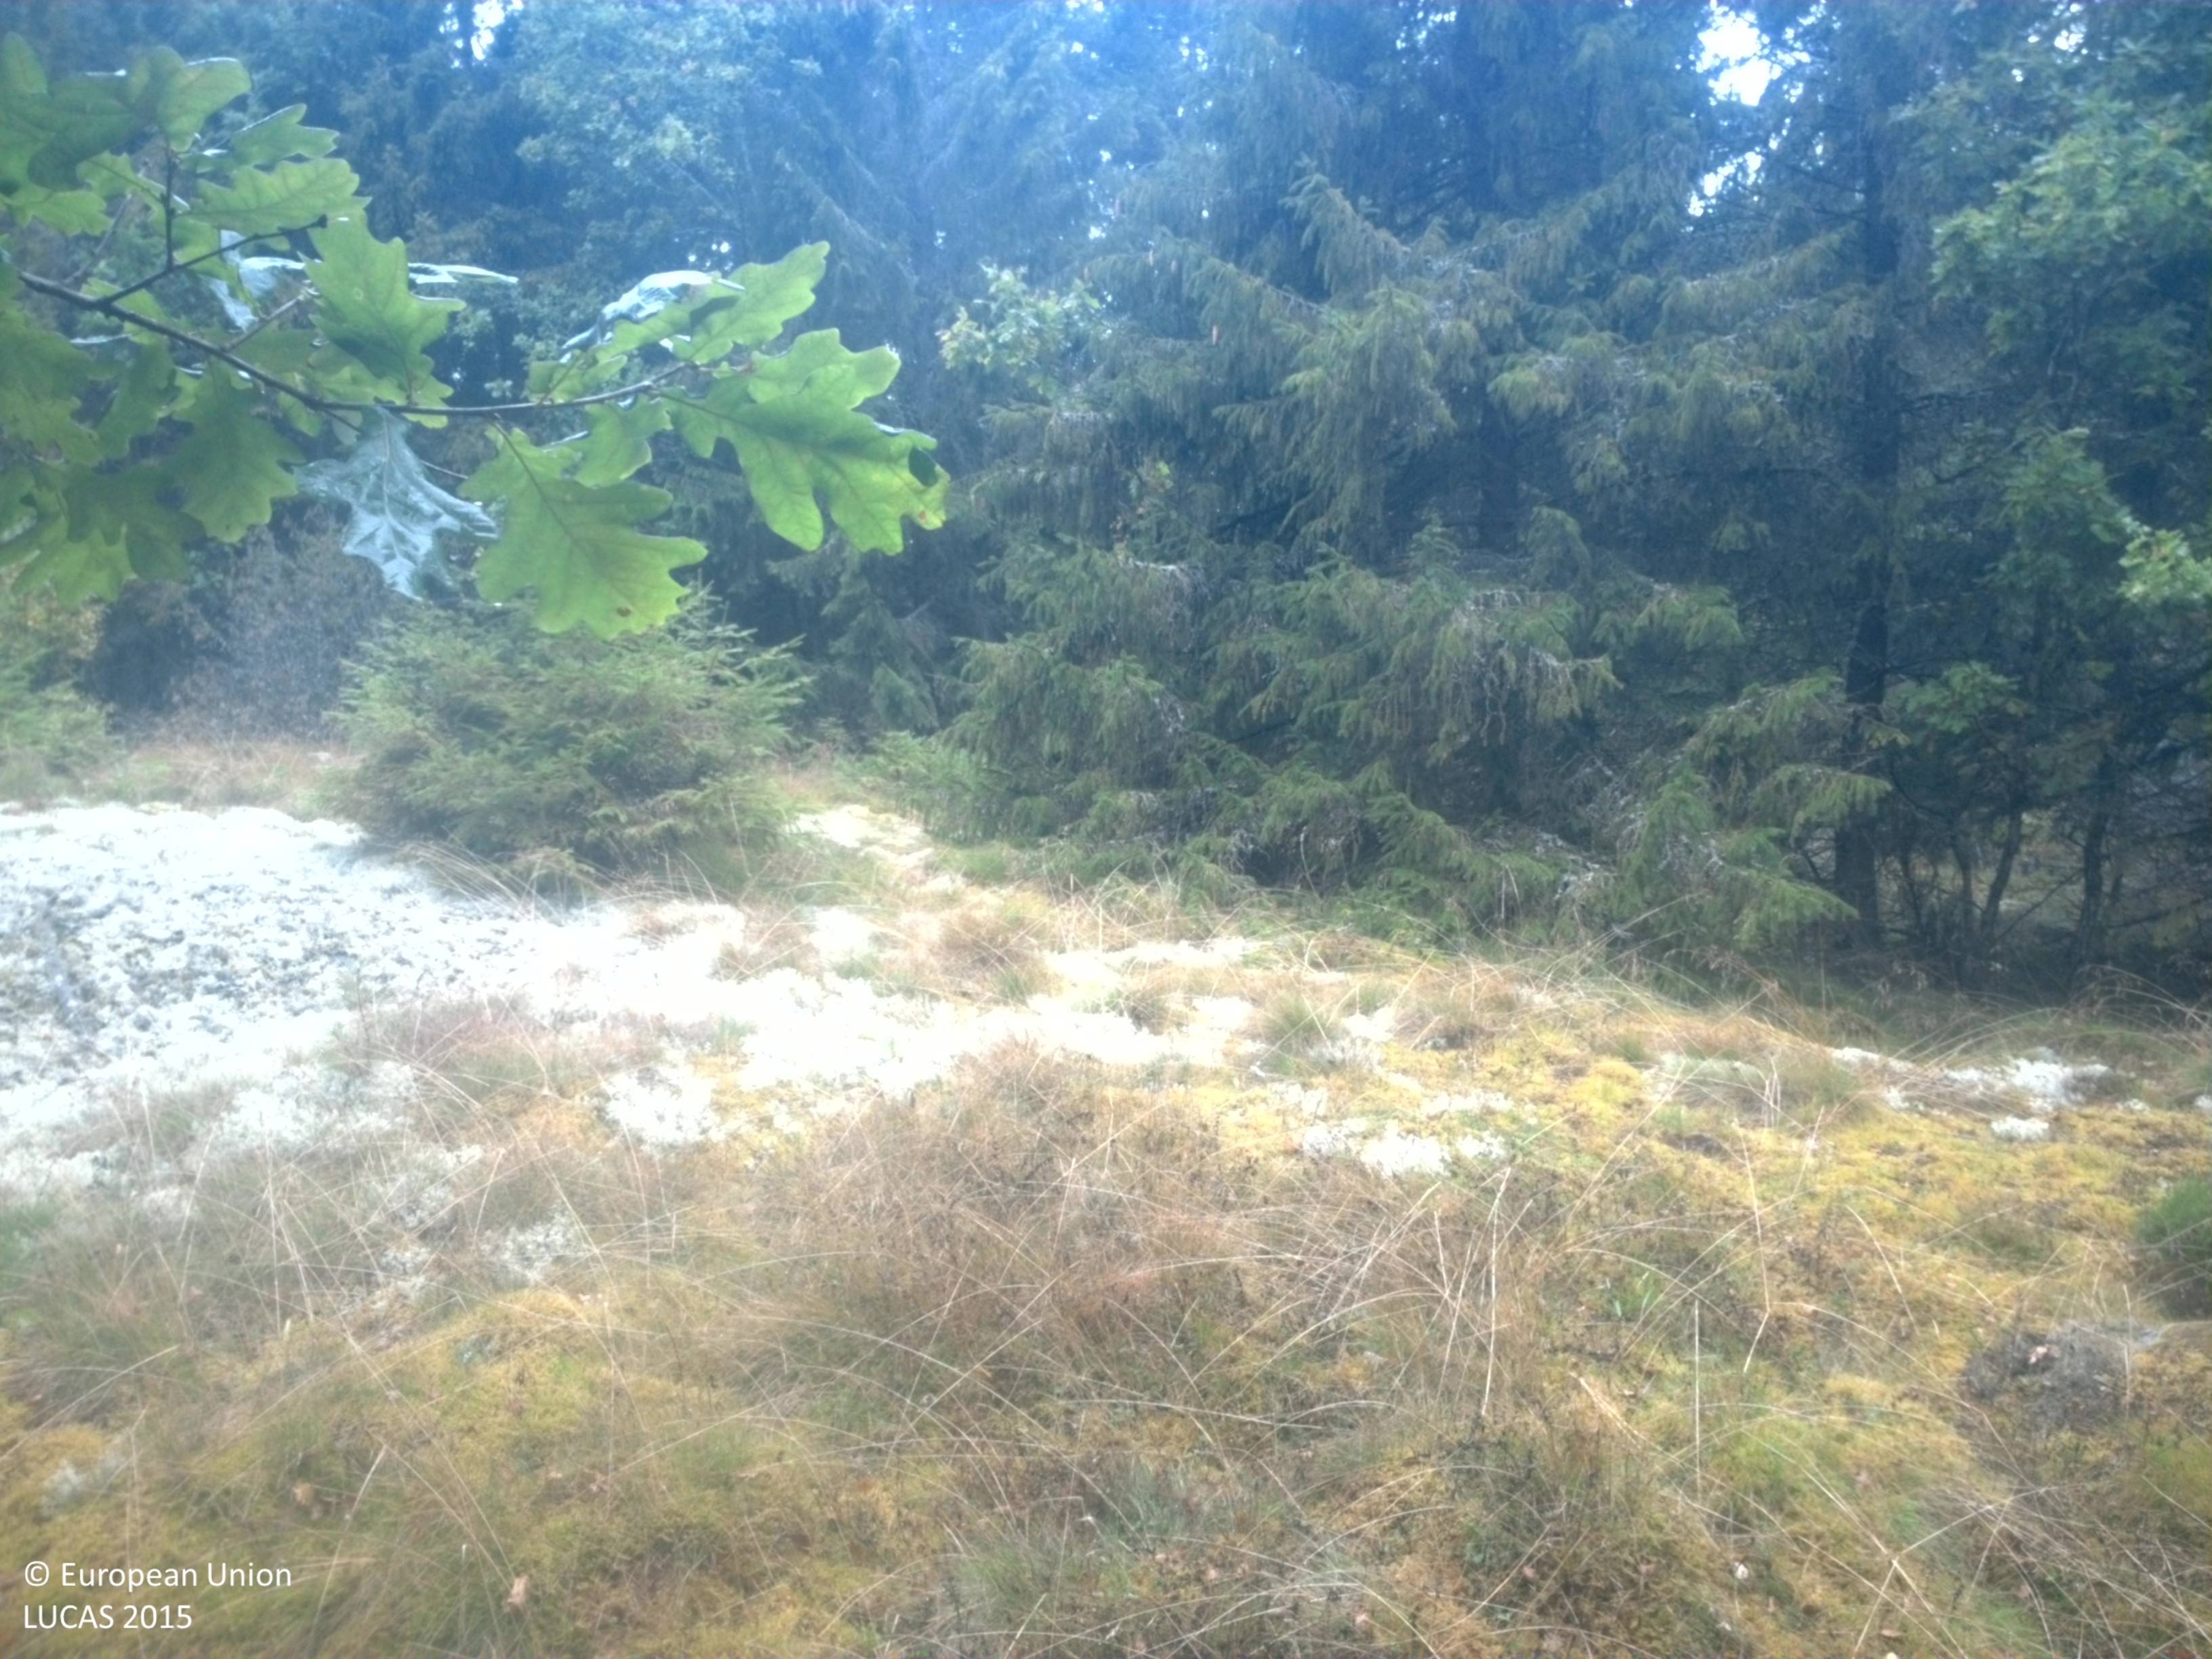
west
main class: Woodland
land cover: Spruce dominated coniferous woodland
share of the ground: 25 - 50 %
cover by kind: coniferous forest trees 35 %, herbaceous plants 30 %, lichens and mosses 30 %, broadleaved forest trees 5 %
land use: Forestry
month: September
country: SE
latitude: 58.8277
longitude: 13.9594
